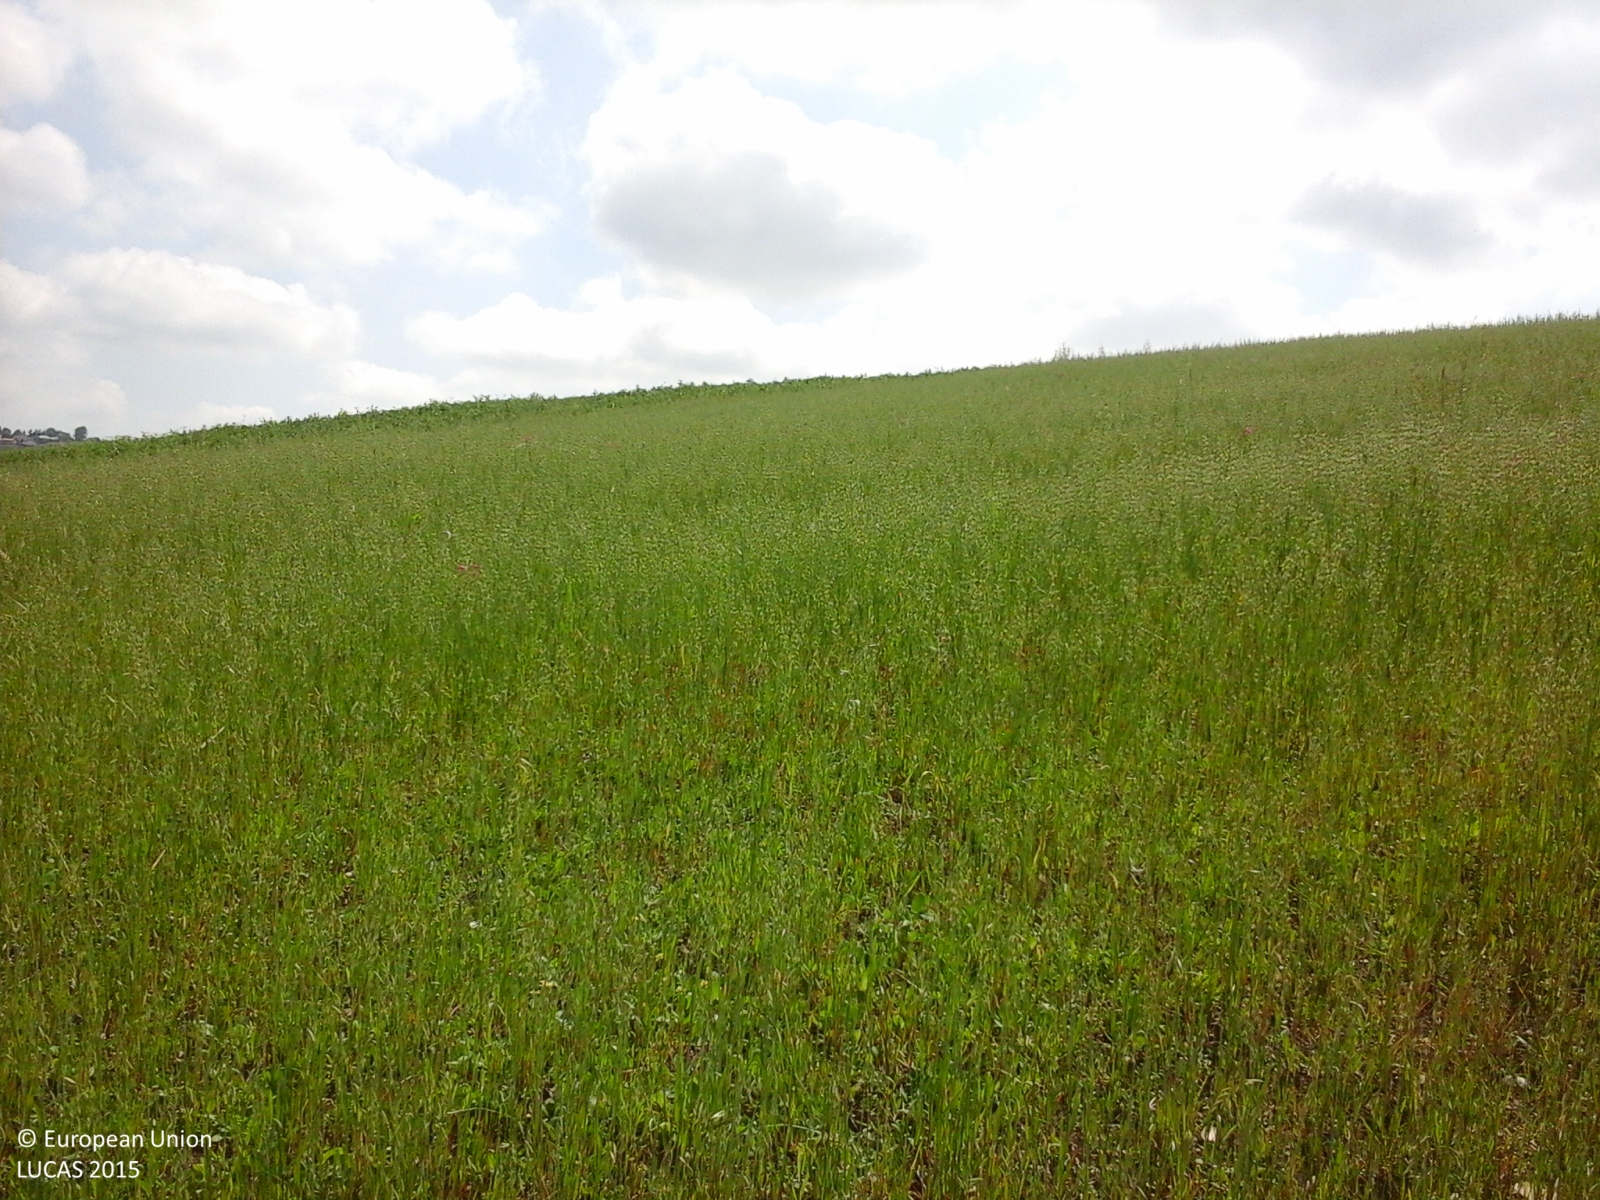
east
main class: Cropland
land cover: Oats
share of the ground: > 75 %
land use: Agriculture (excluding fallow land and kitchen gardens)
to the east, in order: Oats; Ditches and canals; Dry pulses; Mixed cereals for fodder; Tracks; Oats
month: May
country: IT
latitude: 41.2221
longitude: 15.0990
